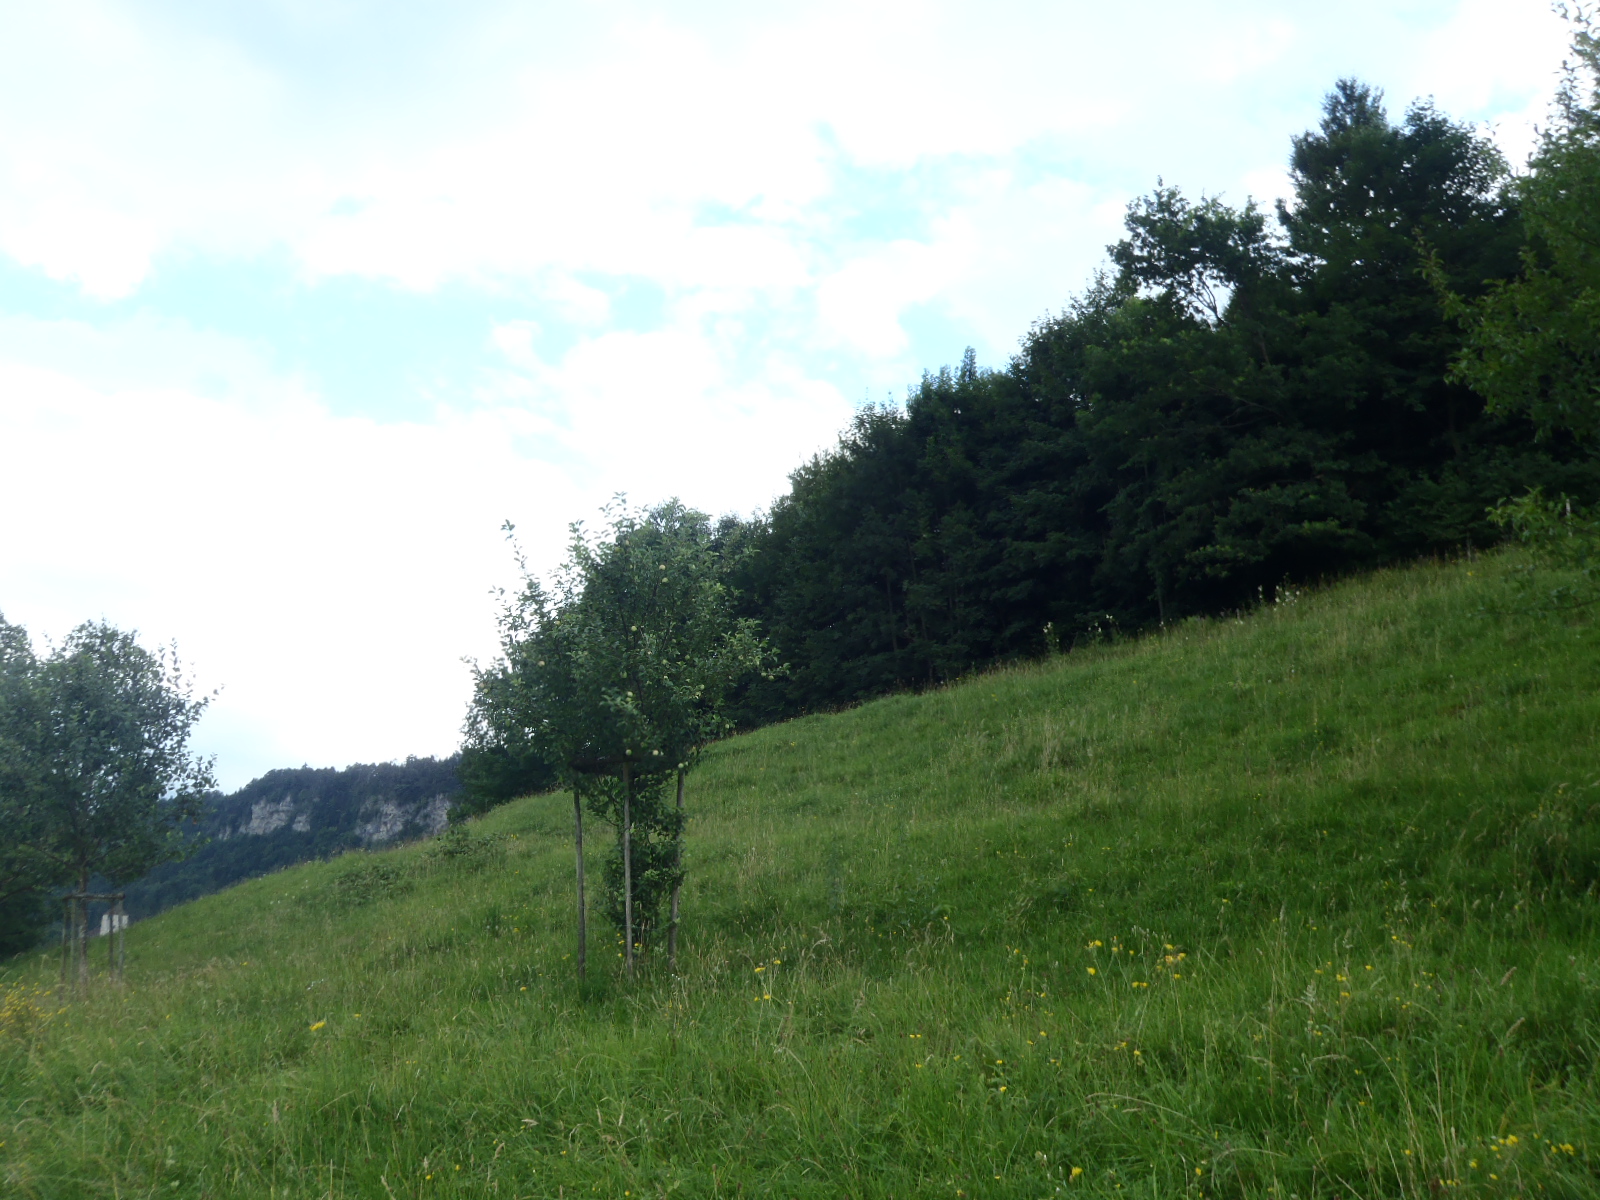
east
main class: Grassland
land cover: Grassland without tree/shrub cover
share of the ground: > 75 %
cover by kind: herbaceous plants 100 %
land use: Agriculture (excluding fallow land and kitchen gardens)
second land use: Amenities, museums, leisure
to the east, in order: Grassland without tree/shrub cover; Tracks; Grassland without tree/shrub cover; Lines of trees; Grassland without tree/shrub cover; Shrubland without tree cover; Fences; Broadleaved woodland
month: July
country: AT
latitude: 47.2328
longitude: 9.5909
